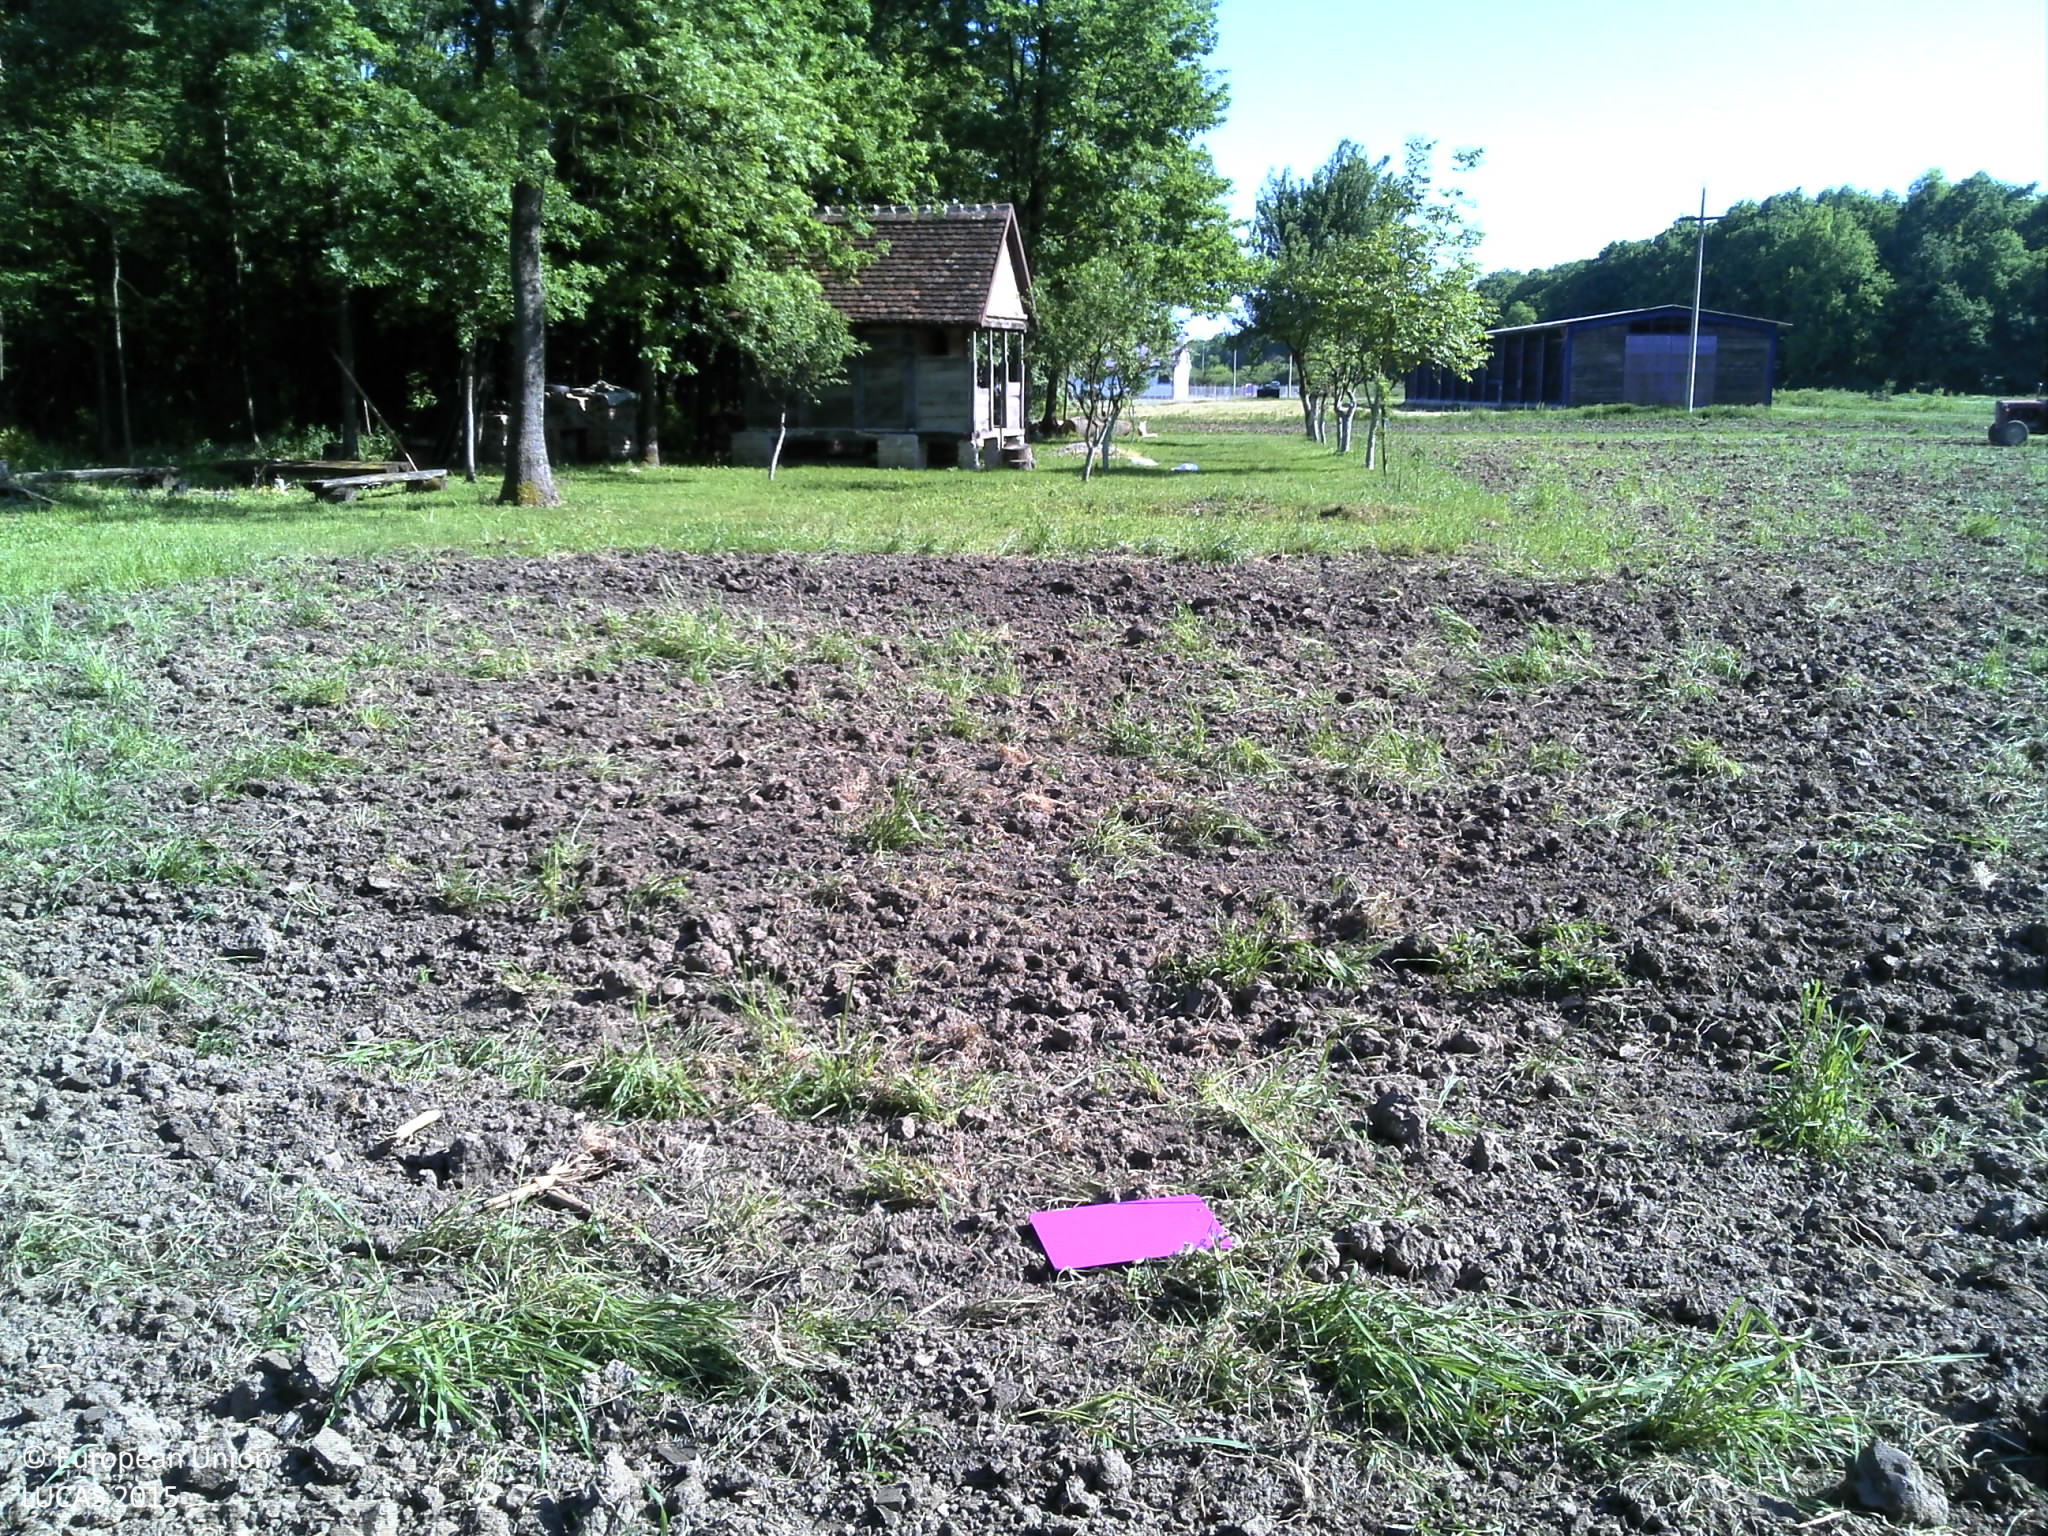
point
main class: Grassland
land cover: Spontaneously vegetated surfaces
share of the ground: < 10 %
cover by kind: unconsolidated bare surface 90 %, herbaceous plants 10 %
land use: Fallow land
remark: Harvested field
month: May
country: HR
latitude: 45.1522
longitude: 18.1563
